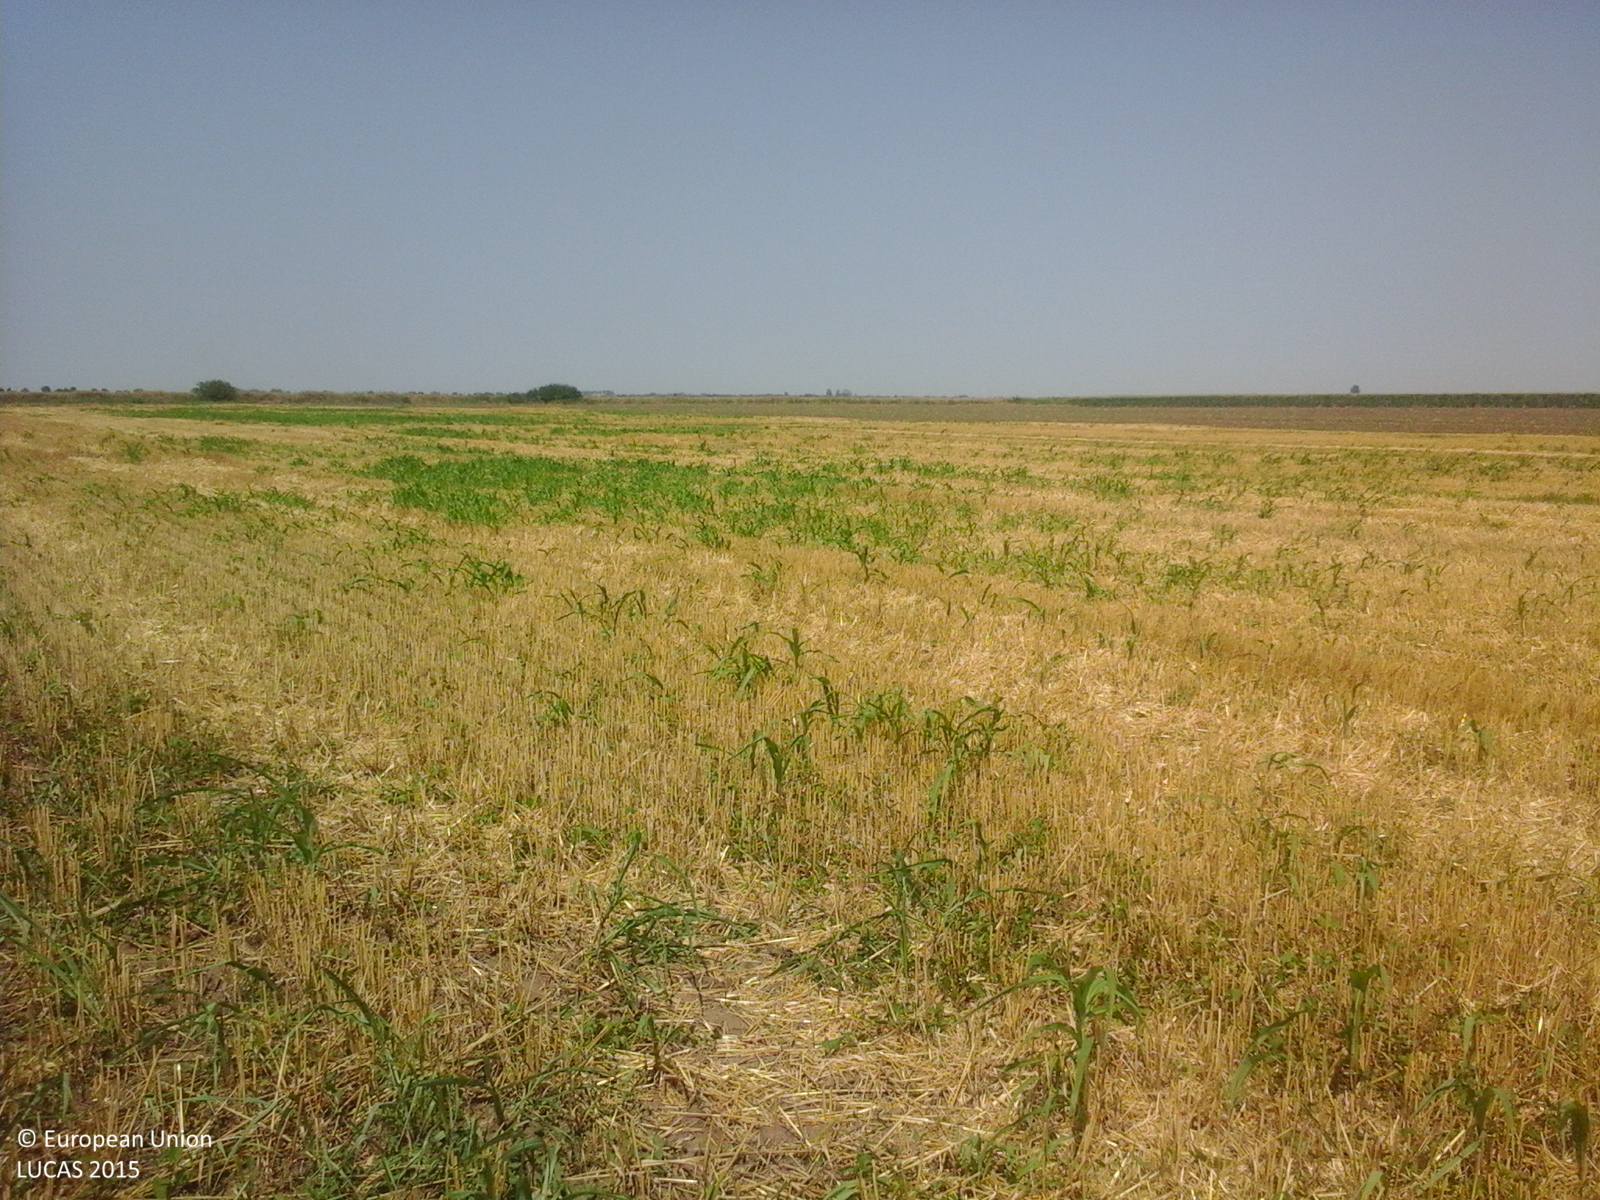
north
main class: Cropland
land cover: Common wheat
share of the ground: 25 - 50 %
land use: Agriculture (excluding fallow land and kitchen gardens)
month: July
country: RO
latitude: 44.7071
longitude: 27.1883
